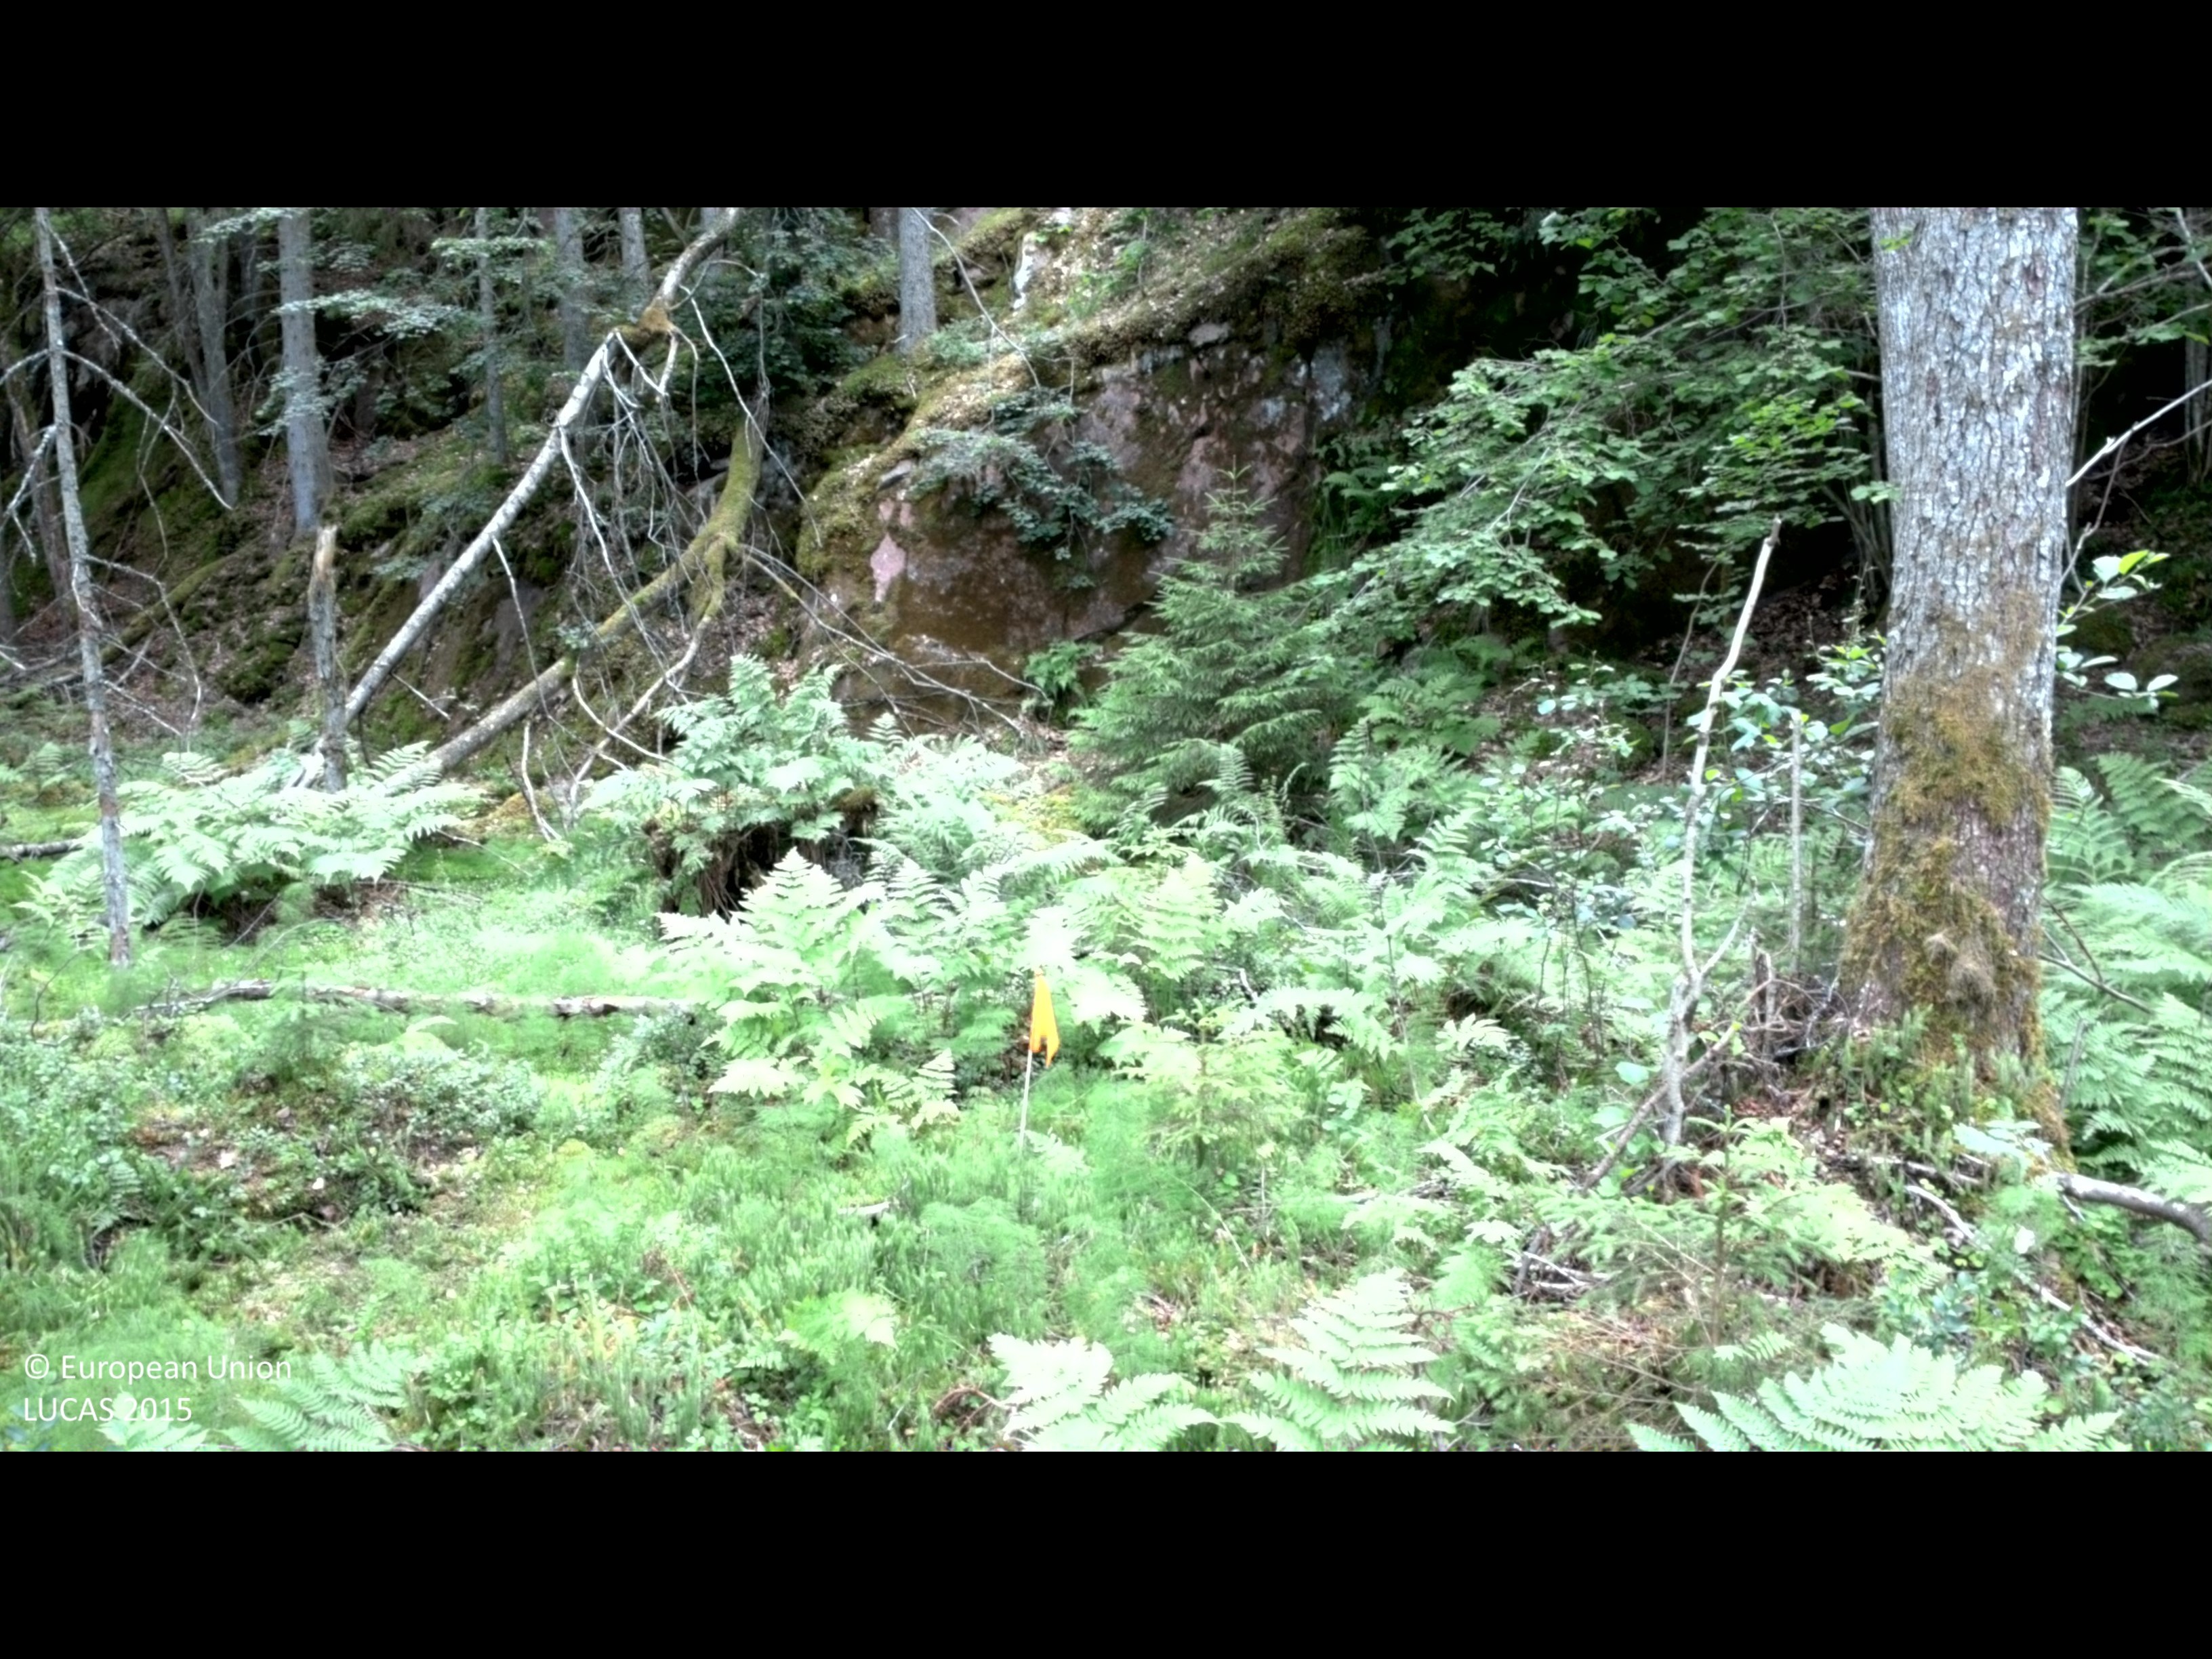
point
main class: Woodland
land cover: Spruce dominated mixed woodland
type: mire and swamp forests
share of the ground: 50 - 75 %
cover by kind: coniferous forest trees 35 %, broadleaved forest trees 25 %, shrubs 15 %, lichens and mosses 15 %, herbaceous plants 10 %
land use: Forestry
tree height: > 5 m
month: July
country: SE
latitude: 57.9549
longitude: 16.0970
